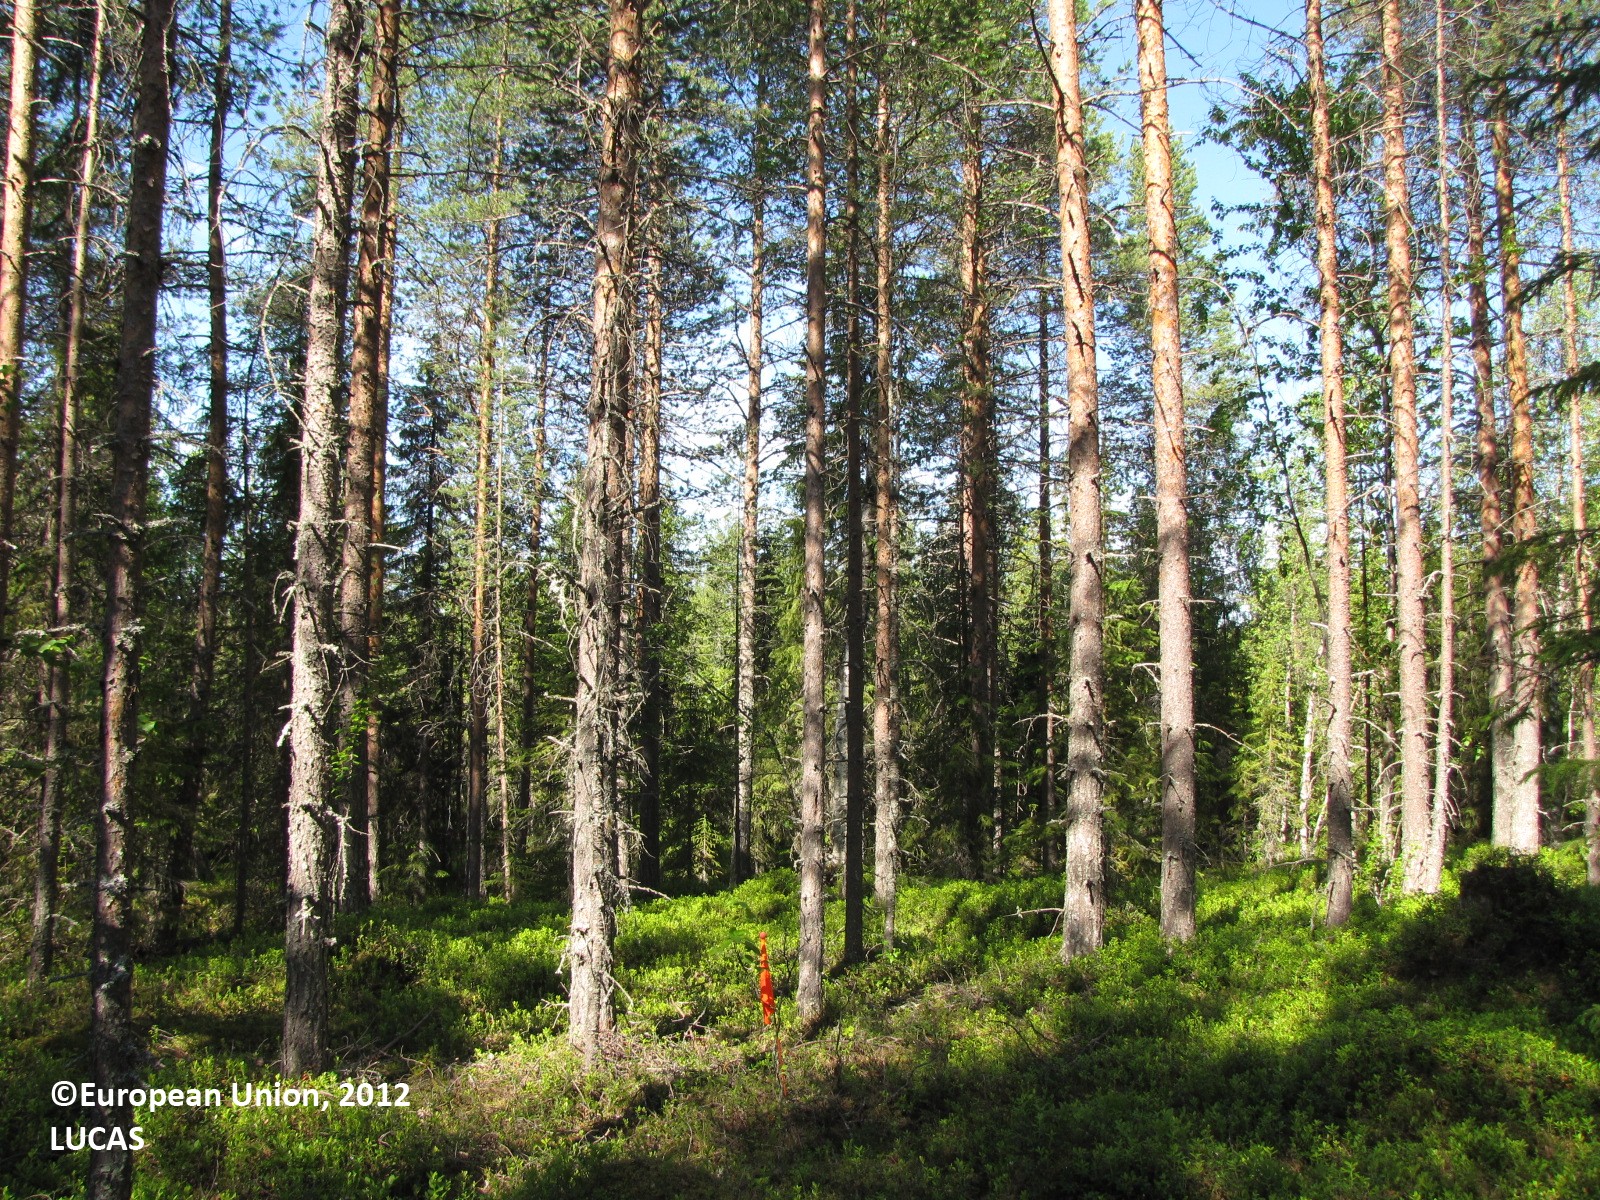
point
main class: Woodland
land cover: Pine dominated coniferous woodland
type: boreal forest
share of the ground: 50 - 75 %
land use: Forestry
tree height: > 5 m
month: July
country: FI
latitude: 66.3704
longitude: 25.2870
